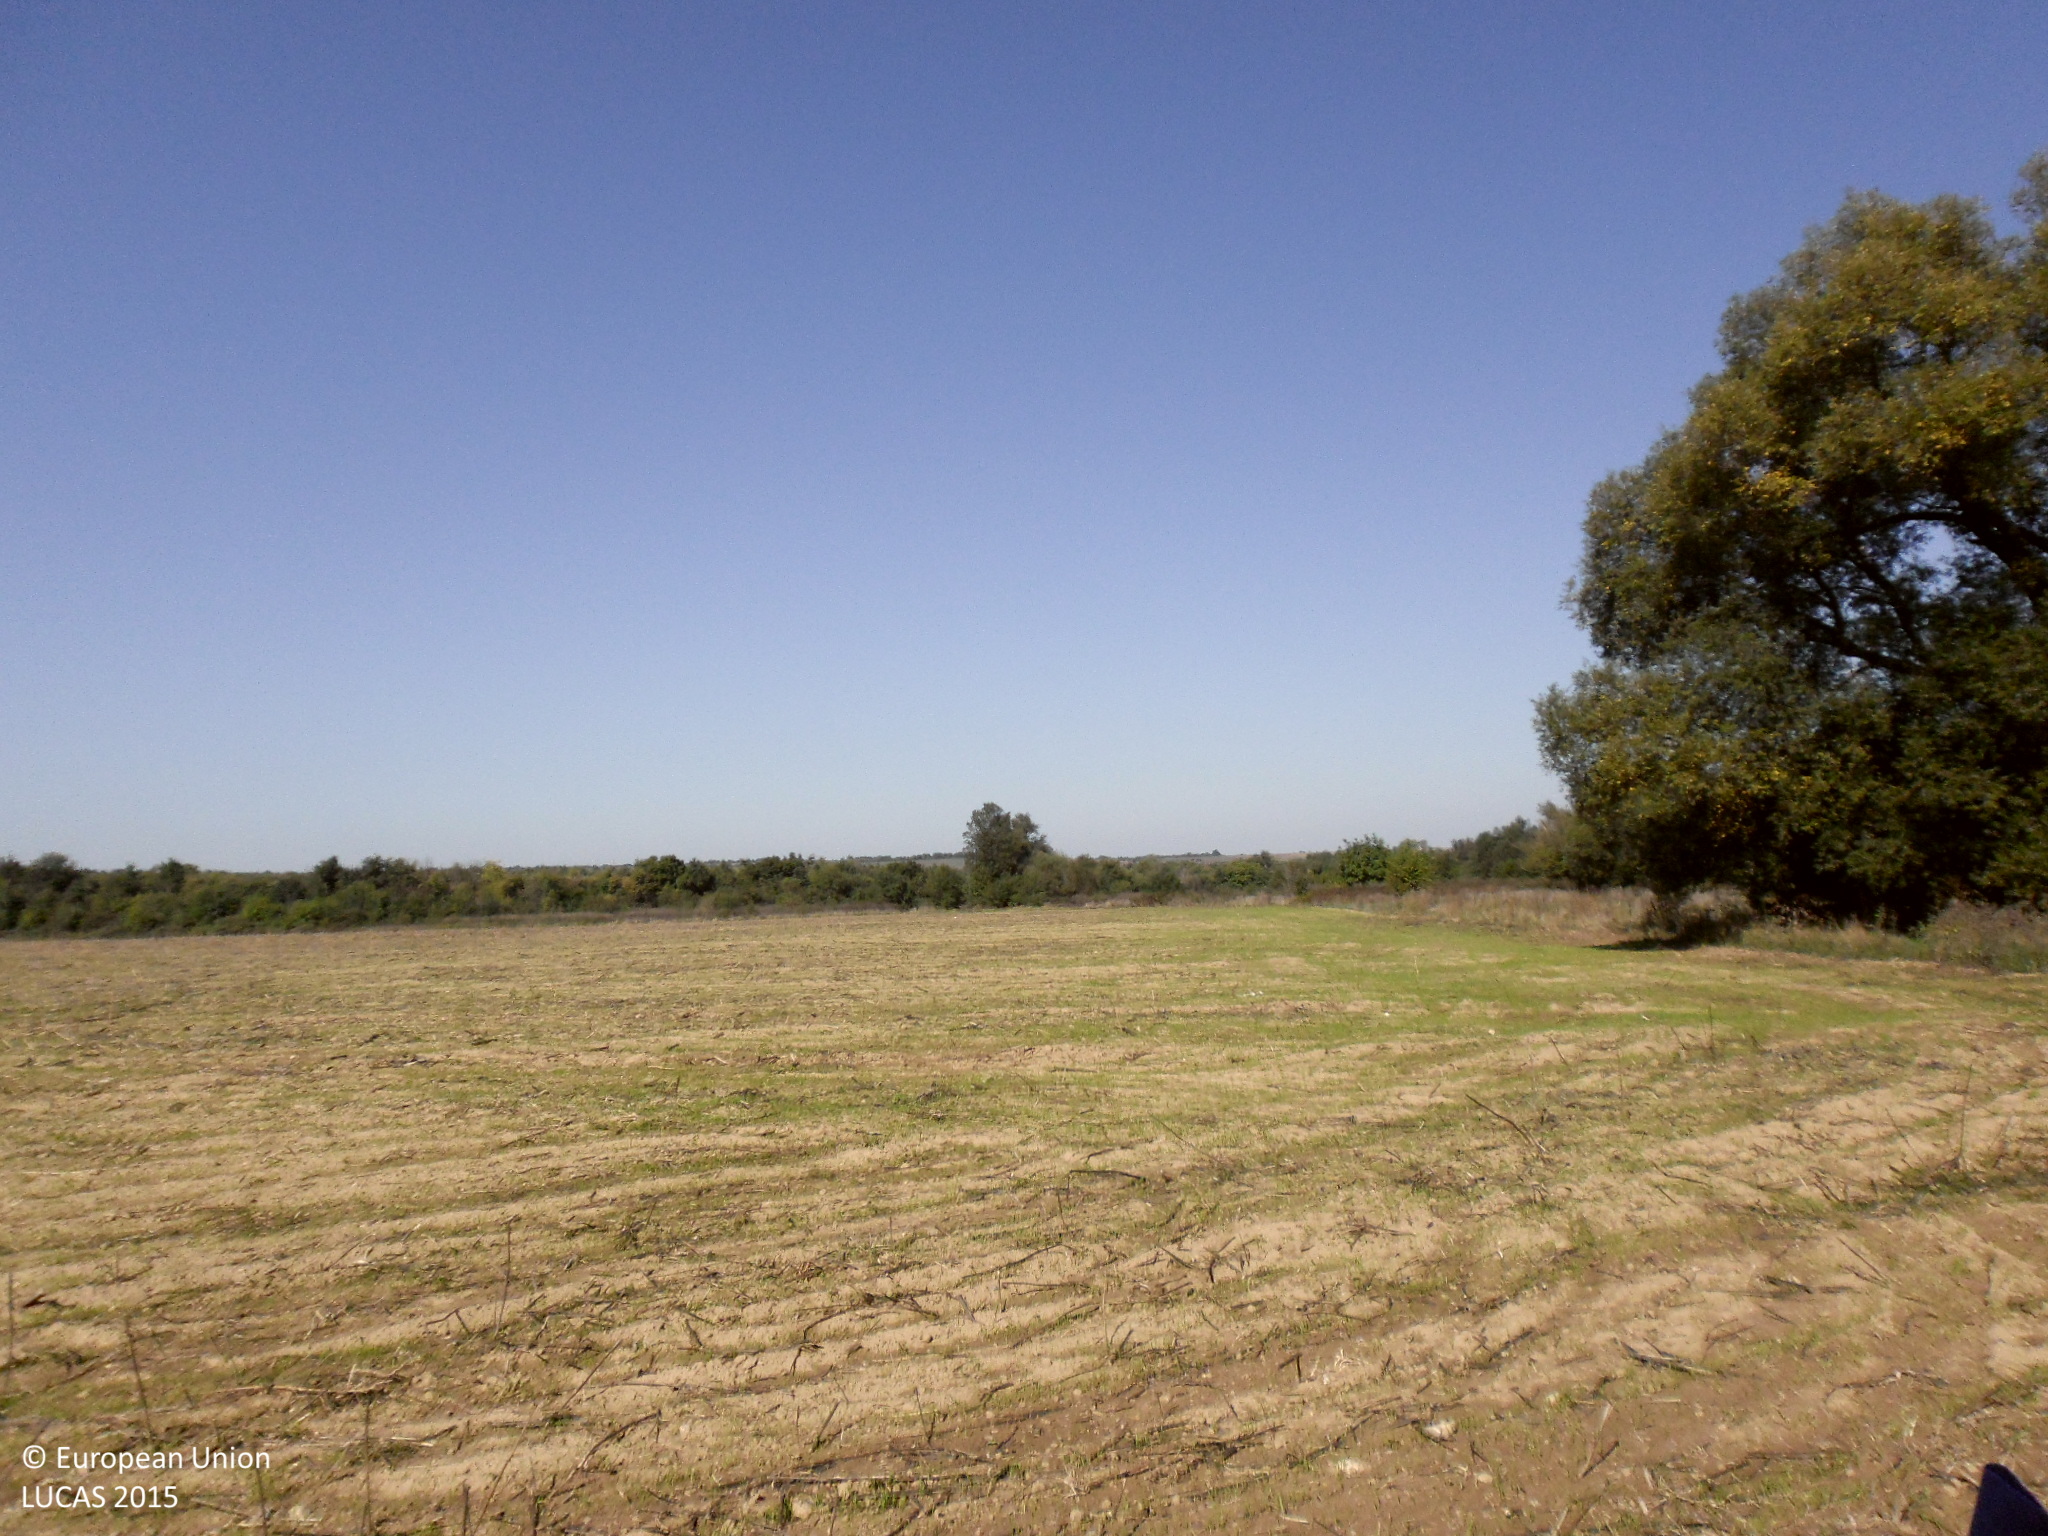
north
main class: Shrubland
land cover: Shrubland with sparse tree cover
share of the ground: > 75 %
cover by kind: shrubs 95 %, broadleaved forest trees 5 %
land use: Semi-natural and natural areas not in use
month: October
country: BG
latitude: 43.6664
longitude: 22.9228
